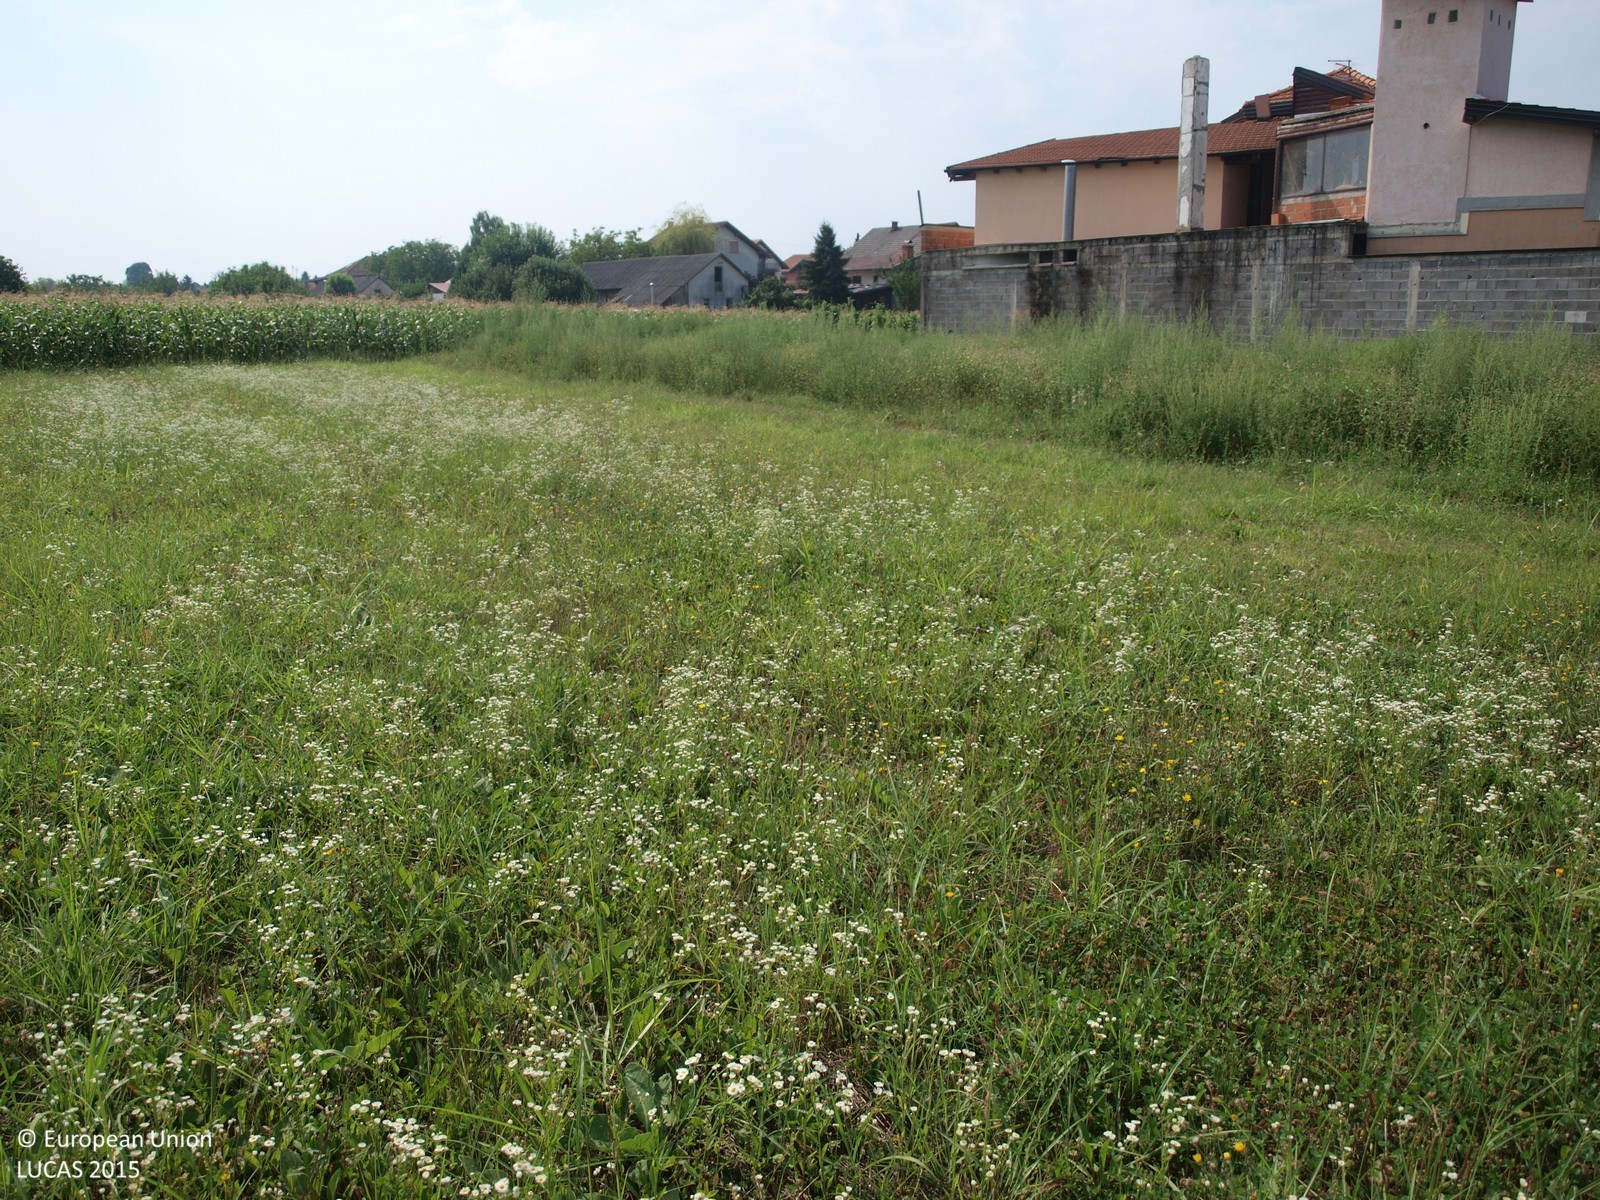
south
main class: Grassland
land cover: Grassland without tree/shrub cover
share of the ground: > 75 %
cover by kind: herbaceous plants 100 %
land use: Agriculture (excluding fallow land and kitchen gardens)
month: August
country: HR
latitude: 45.7758
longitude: 15.8491
